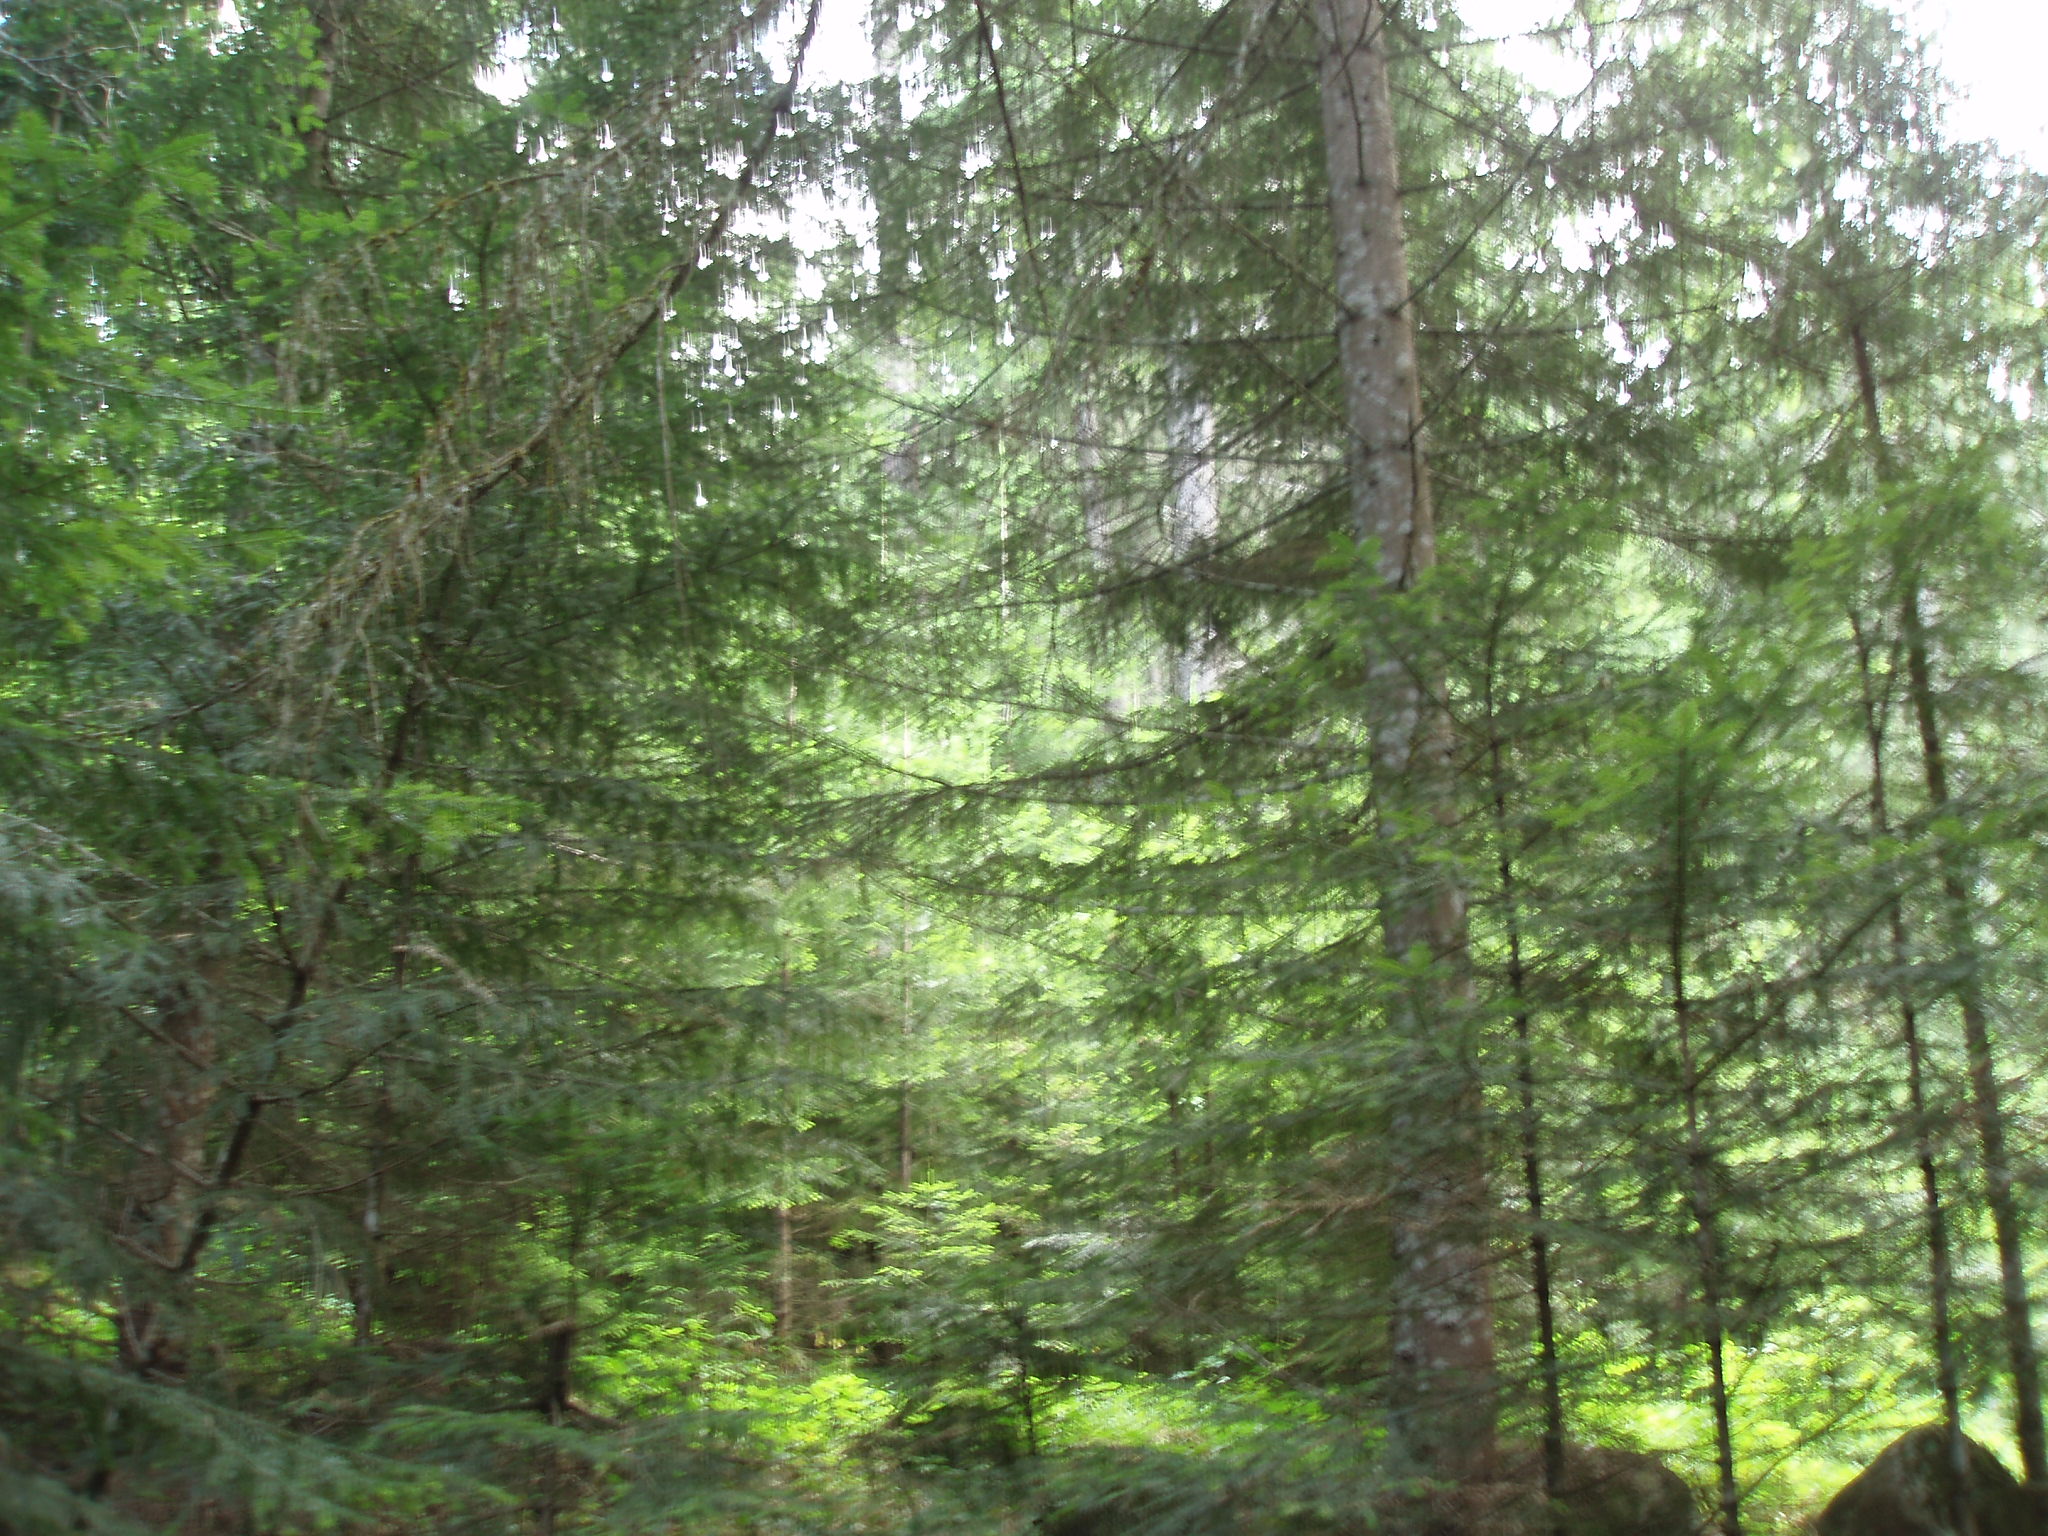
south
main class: Woodland
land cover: Spruce dominated mixed woodland
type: hemiboreal forest and nemoral coniferous forest and mixed broadleaved-coniferous forest
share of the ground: > 75 %
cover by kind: coniferous forest trees 75 %, broadleaved forest trees 25 %
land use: Amenities, museums, leisure
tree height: > 5 m
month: July
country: BG
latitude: 41.8043
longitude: 23.4713
